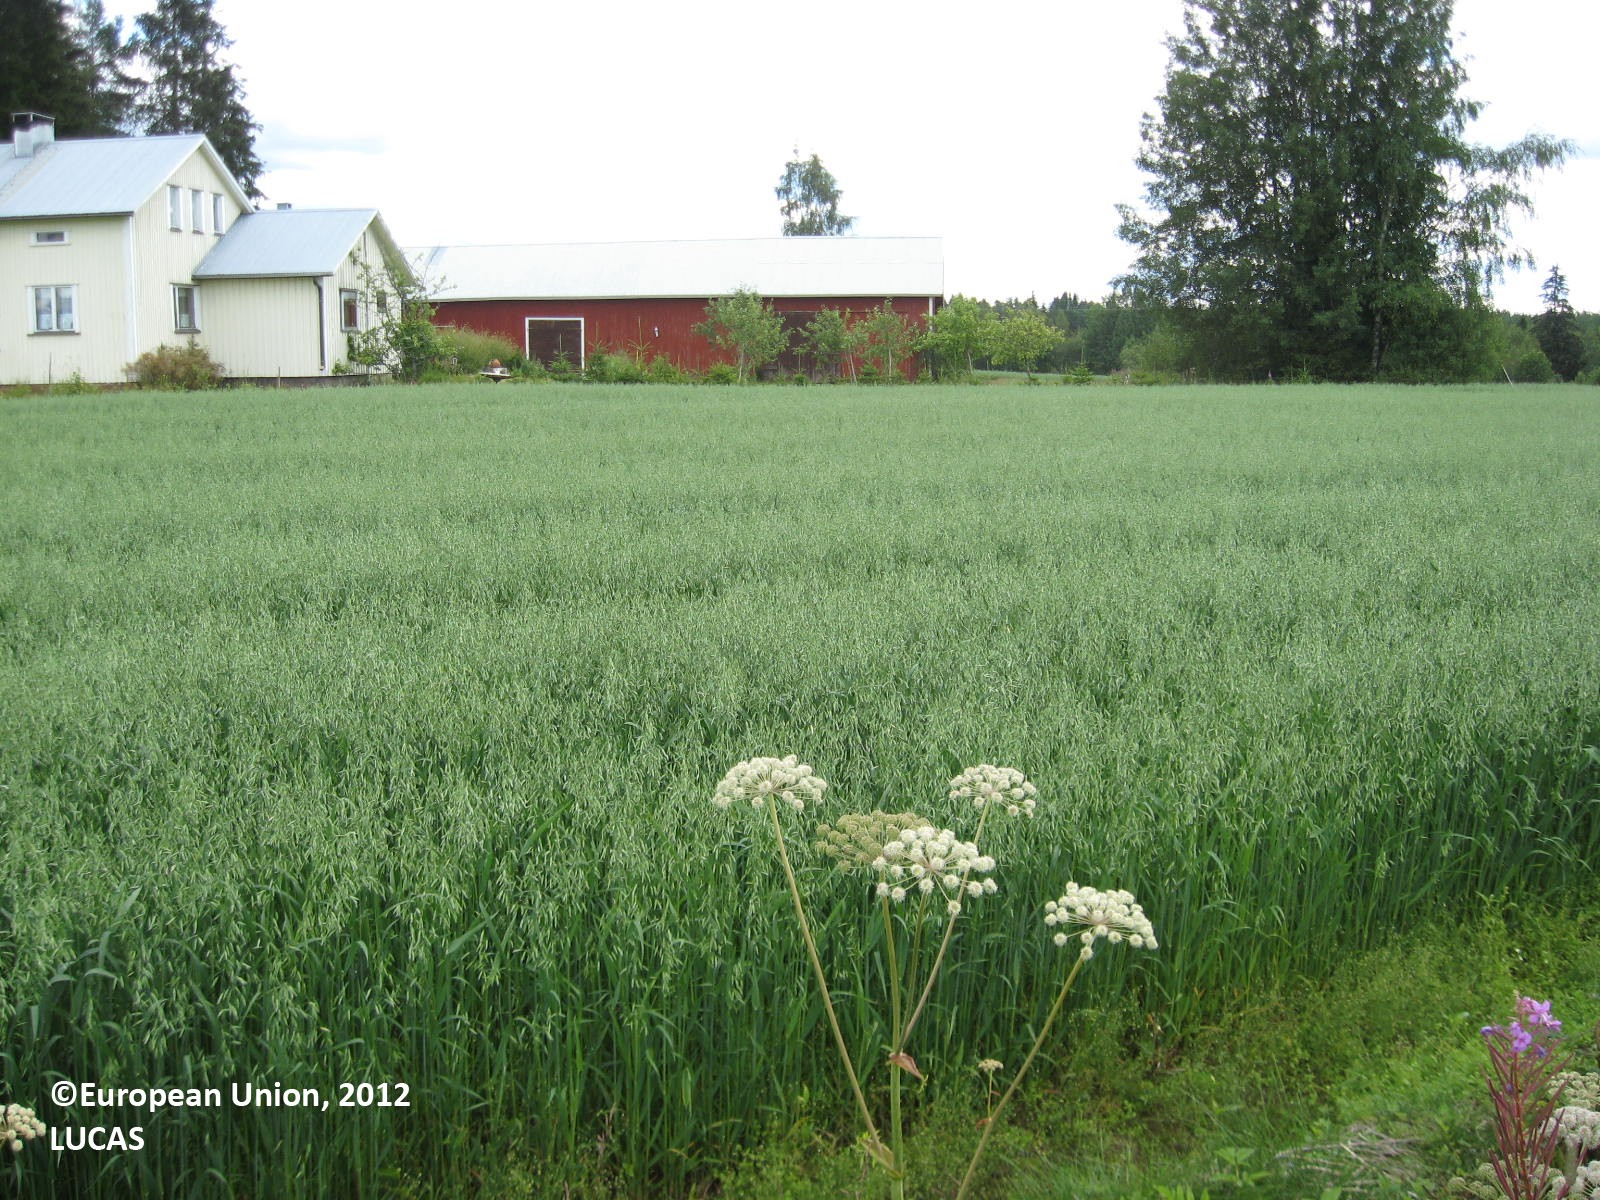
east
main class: Cropland
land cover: Barley
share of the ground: > 75 %
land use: Agriculture (excluding fallow land and kitchen gardens)
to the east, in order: Barley; Shruby margins; Ditches and canals; Grass margins; Electric lines; Oats; Grass margins; Lines of trees; Grassland with sparse tree/shrub cover; Tracks; Artificial constructions in urban areas; Single bushes/trees; Grass margins; Oats
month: July
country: FI
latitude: 62.0914
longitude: 22.2549
